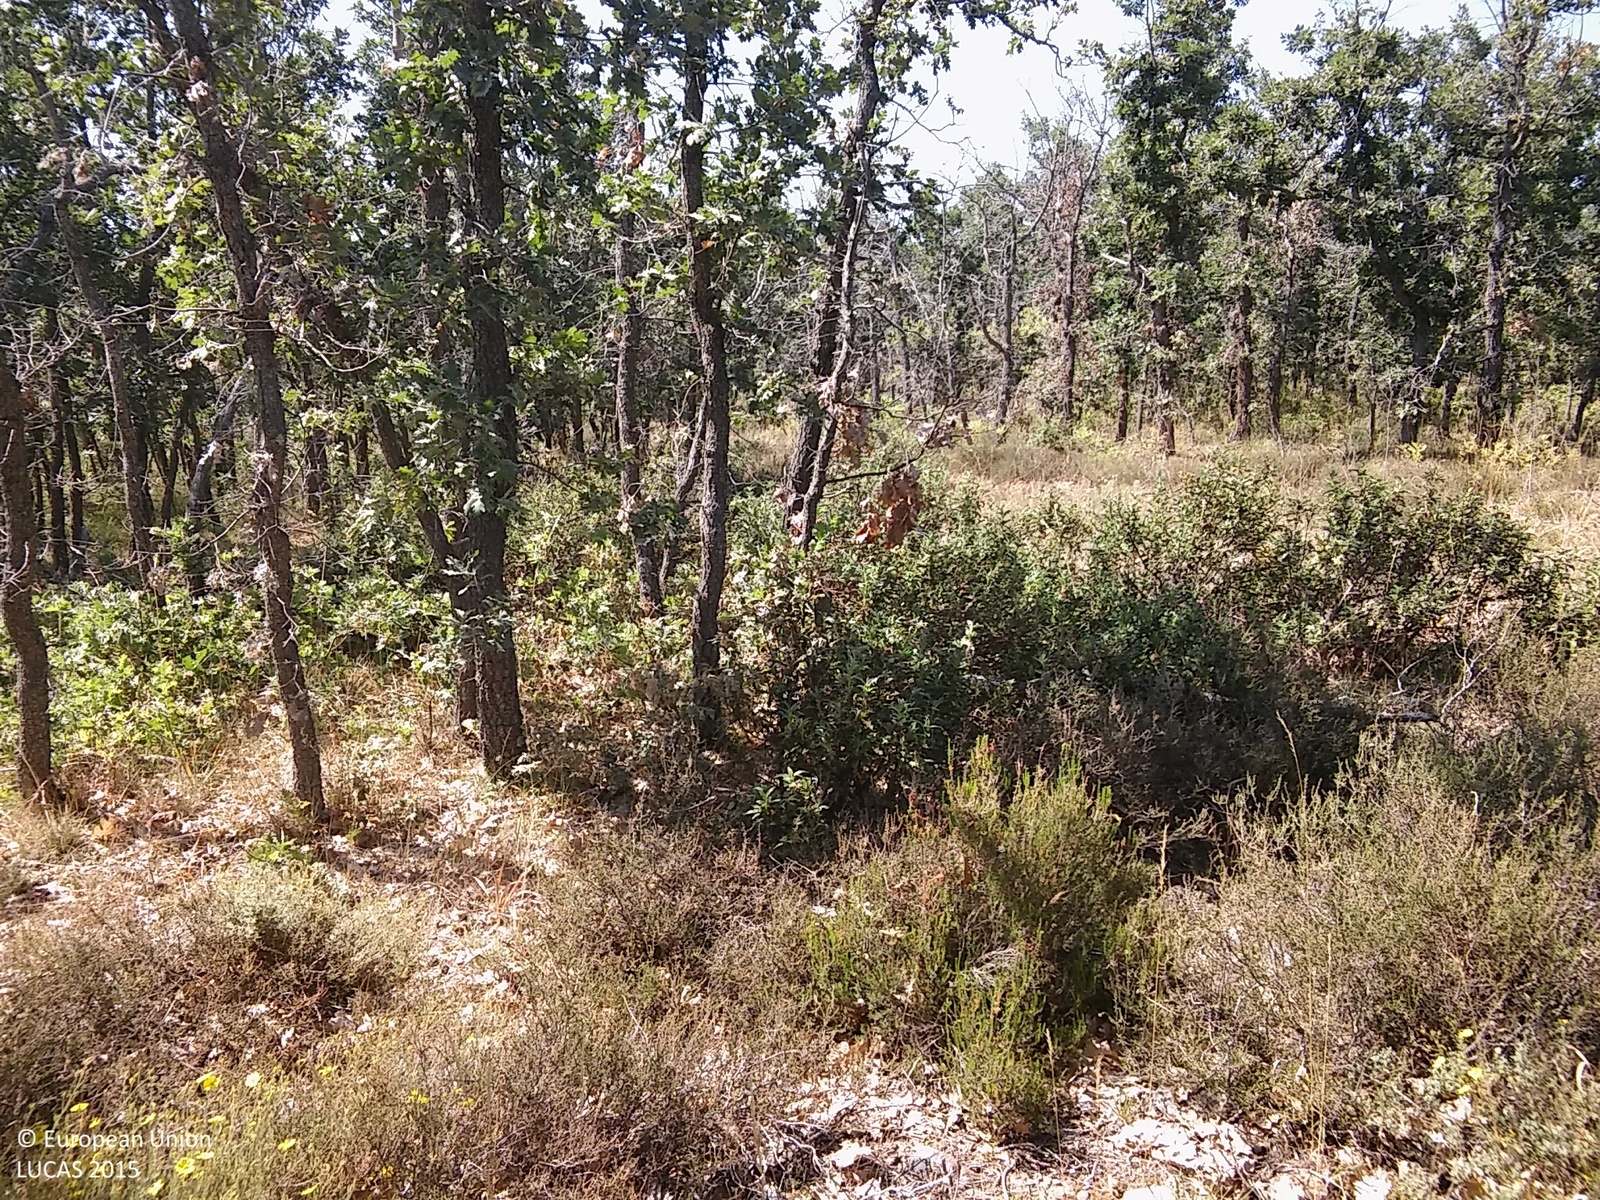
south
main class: Woodland
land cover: Broadleaved woodland
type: acidophilous oak and oak-birch forest
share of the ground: 50 - 75 %
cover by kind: broadleaved forest trees 50 %, shrubs 30 %, herbaceous plants 10 %, unconsolidated bare surface 10 %
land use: Forestry
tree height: > 5 m
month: July
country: ES
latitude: 41.3089
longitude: -3.4831
